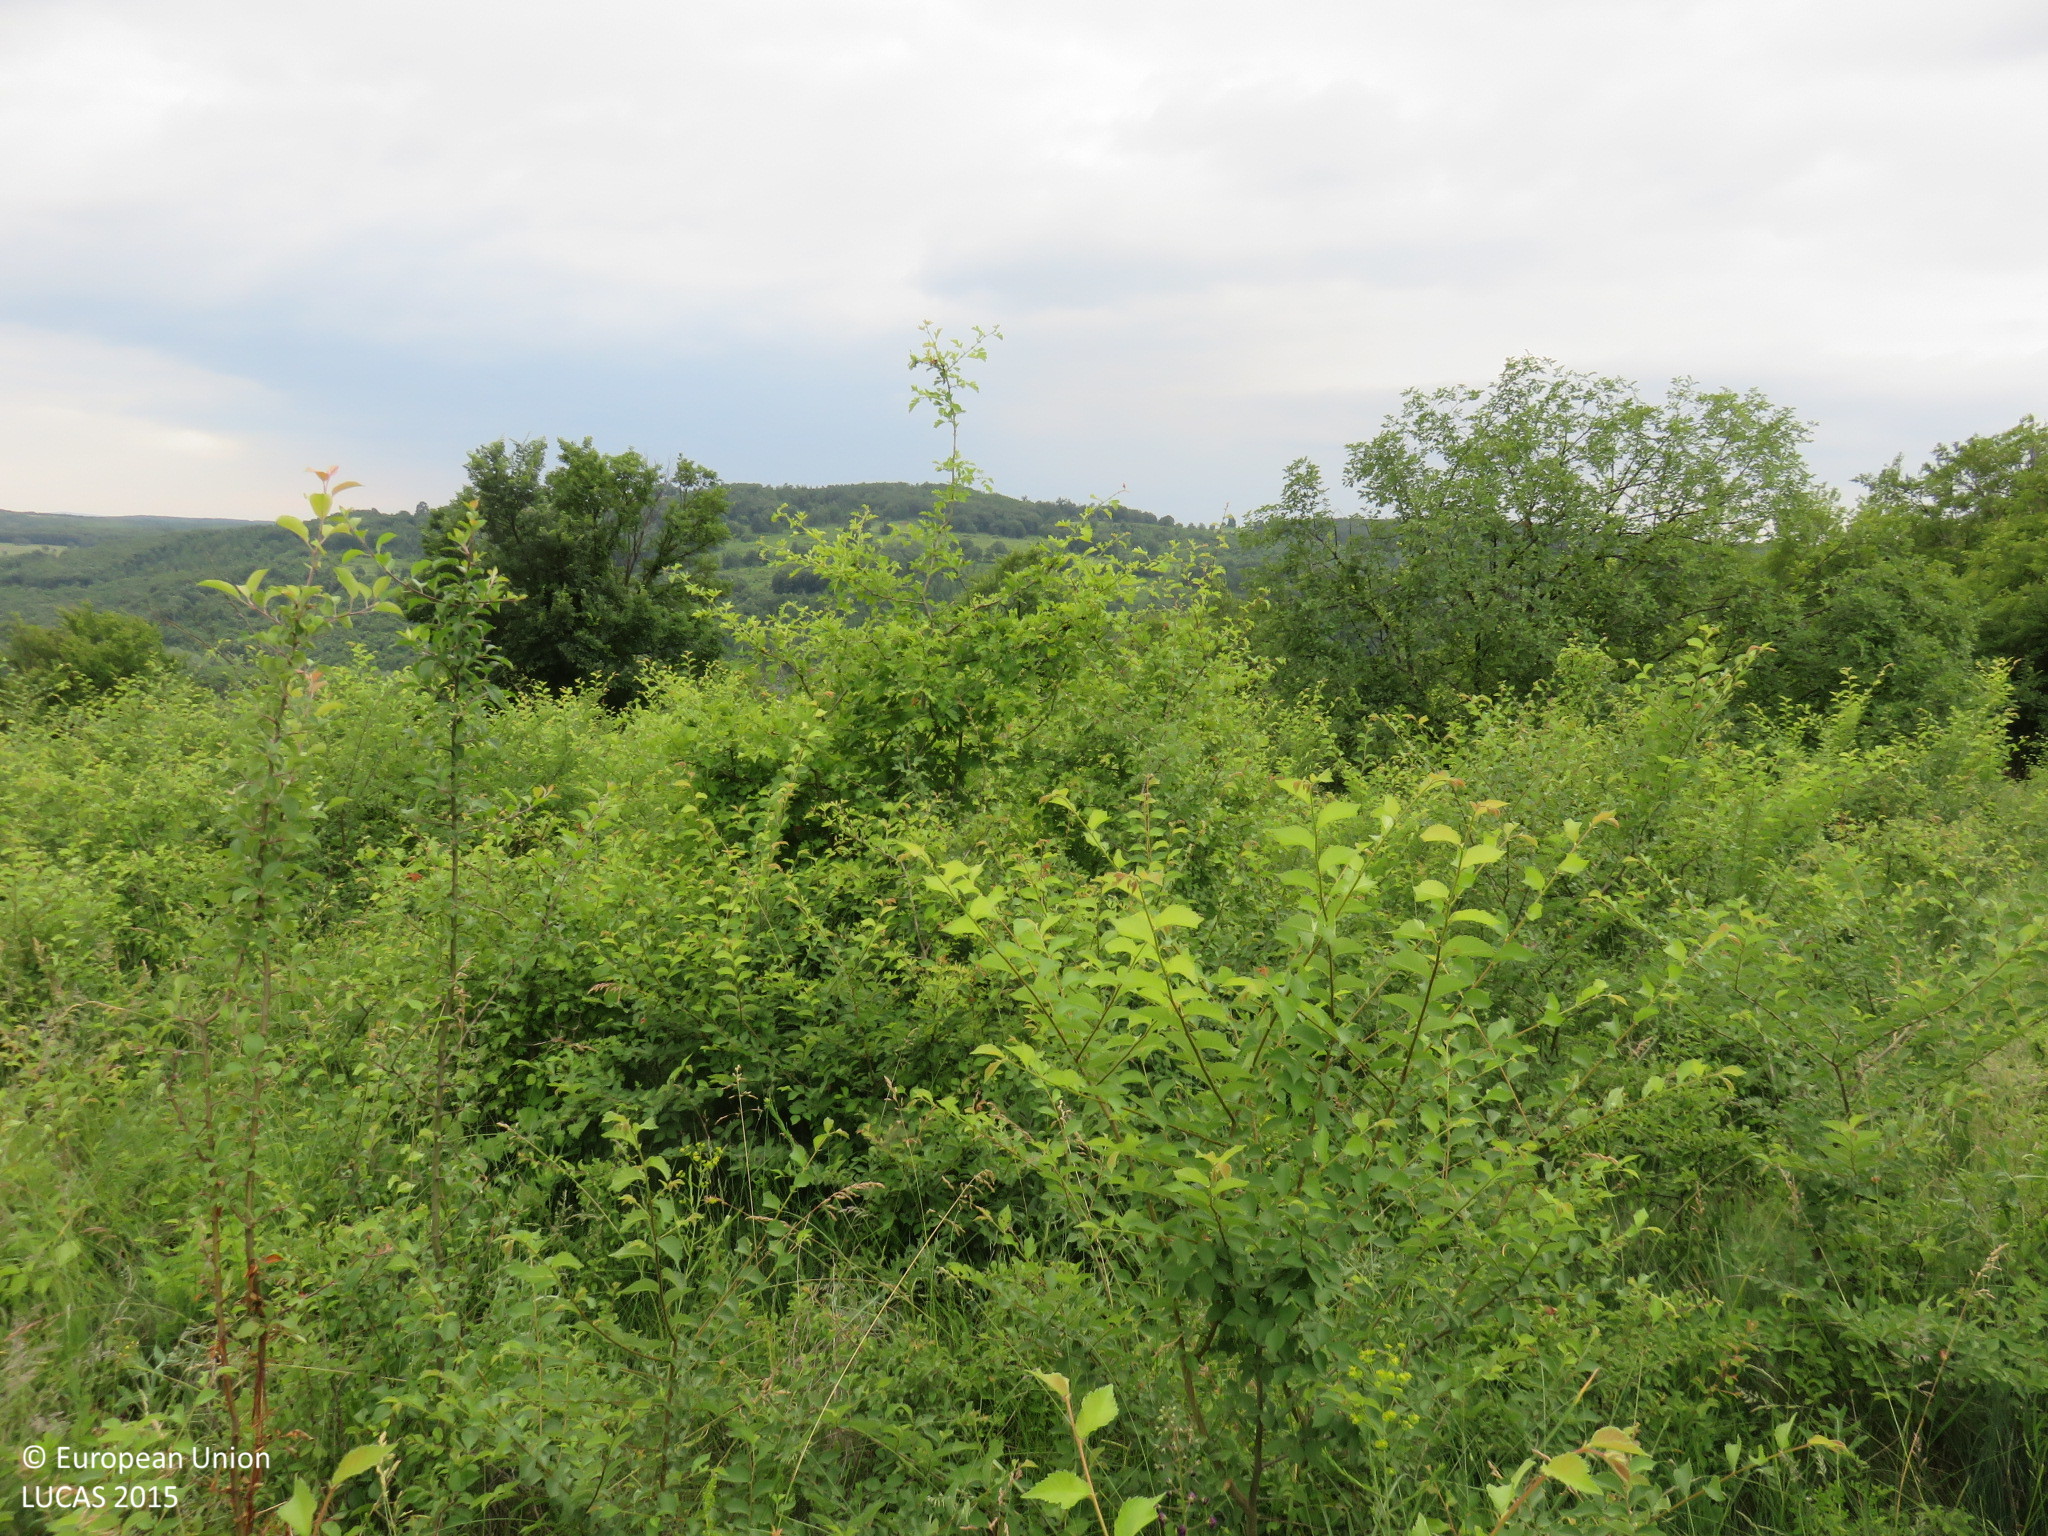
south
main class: Shrubland
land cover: Shrubland without tree cover
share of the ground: > 75 %
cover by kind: shrubs 85 %, herbaceous plants 15 %
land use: Fallow land
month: May
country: BG
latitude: 43.2196
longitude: 24.4741
